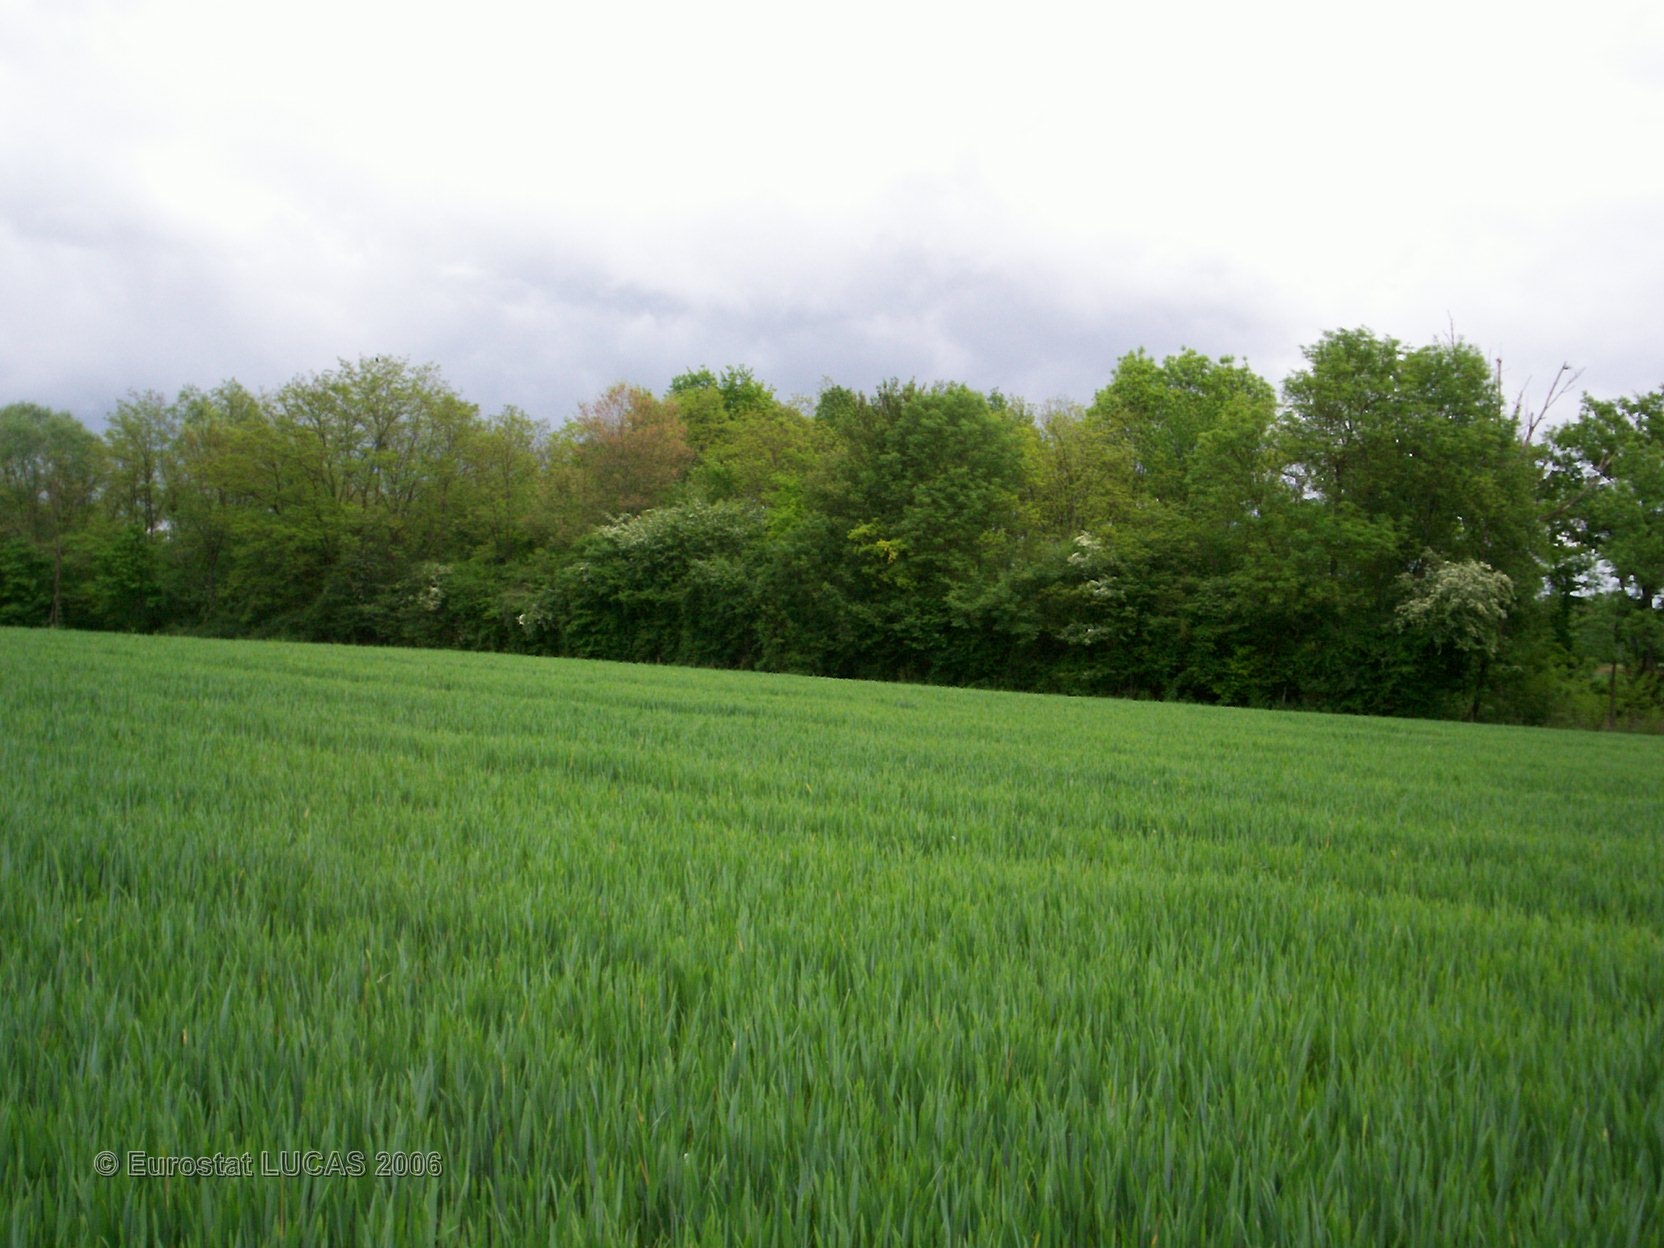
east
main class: Cropland
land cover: Barley
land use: Agriculture (excluding fallow land and kitchen gardens)
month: May
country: FR
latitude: 46.2419
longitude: 5.1654
